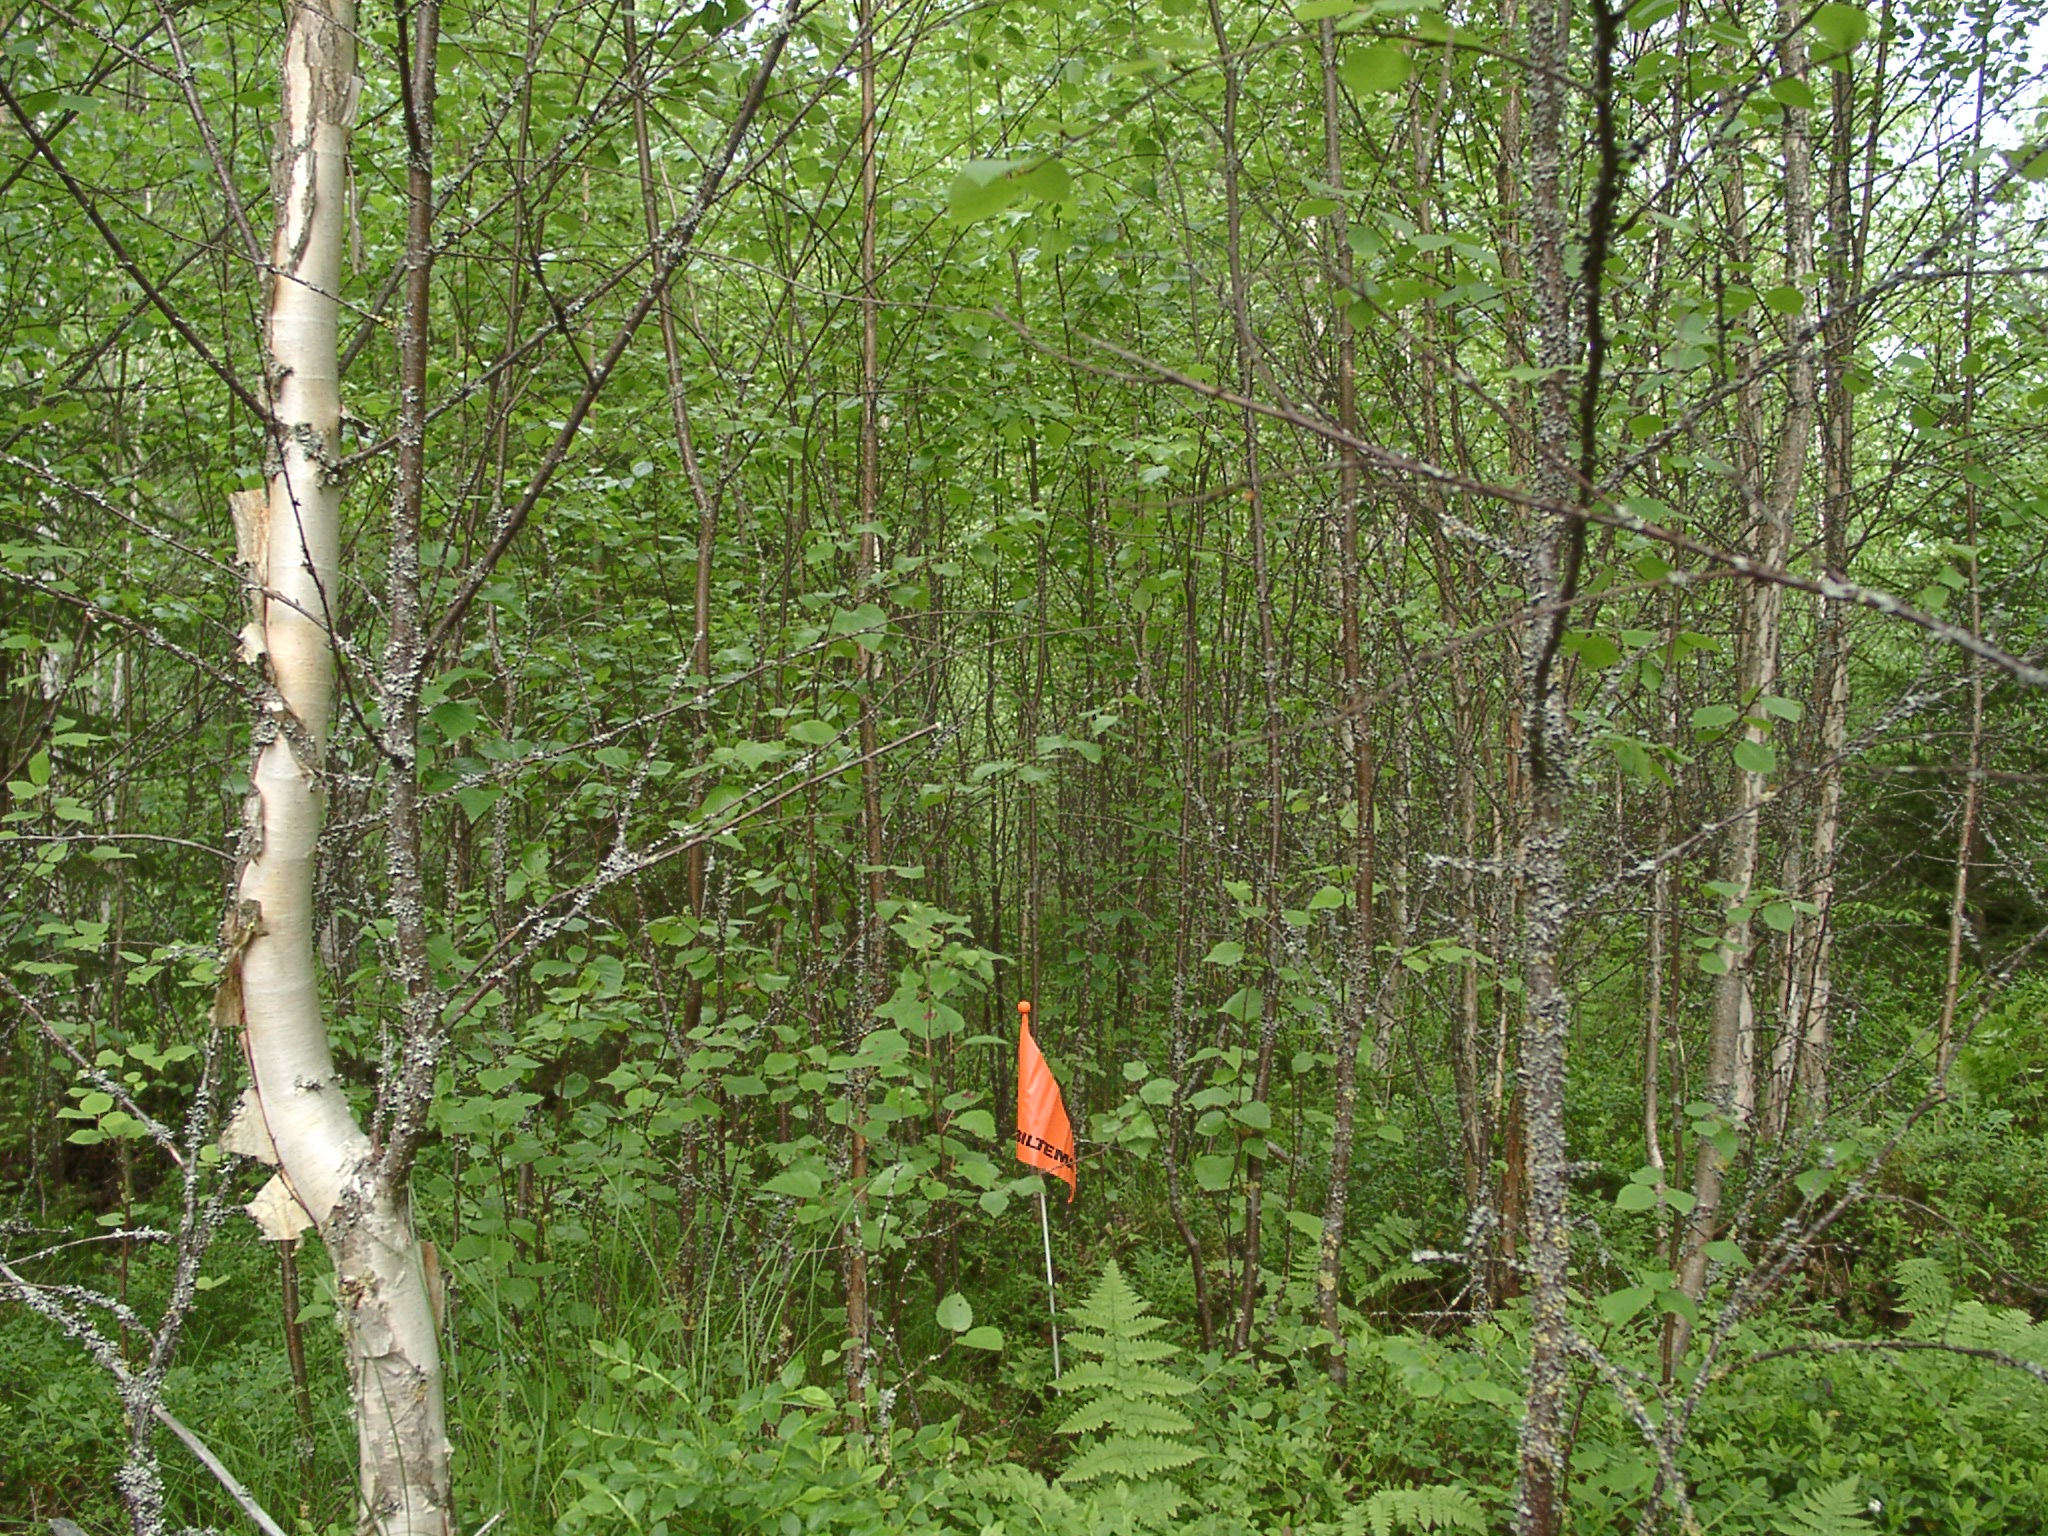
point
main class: Woodland
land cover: Broadleaved woodland
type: non-riverine alder, birch or aspen forest
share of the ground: 50 - 75 %
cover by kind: broadleaved forest trees 60 %, shrubs 30 %, coniferous forest trees 5 %, lichens and mosses 5 %
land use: Forestry
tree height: < 5 m
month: June
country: FI
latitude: 61.8925
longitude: 24.8095
